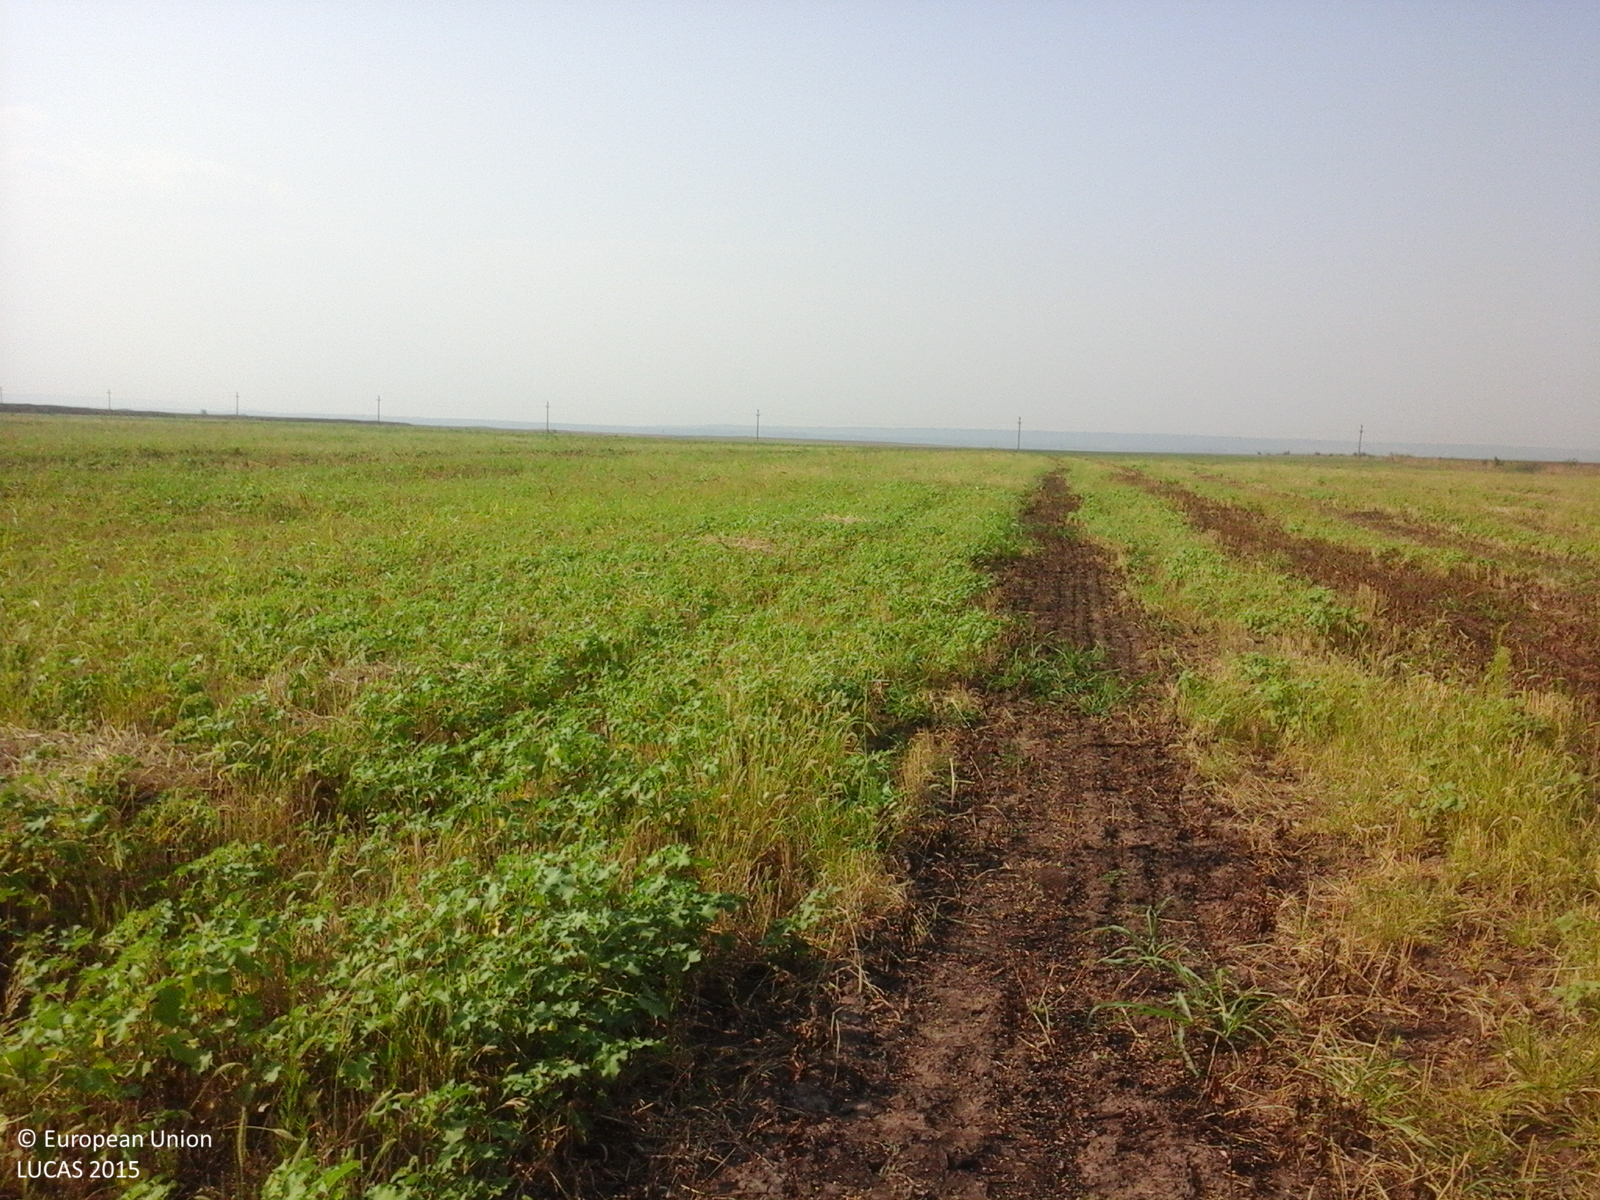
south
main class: Cropland
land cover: Common wheat
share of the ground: 25 - 50 %
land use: Agriculture (excluding fallow land and kitchen gardens)
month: August
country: RO
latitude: 43.9286
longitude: 23.4376
